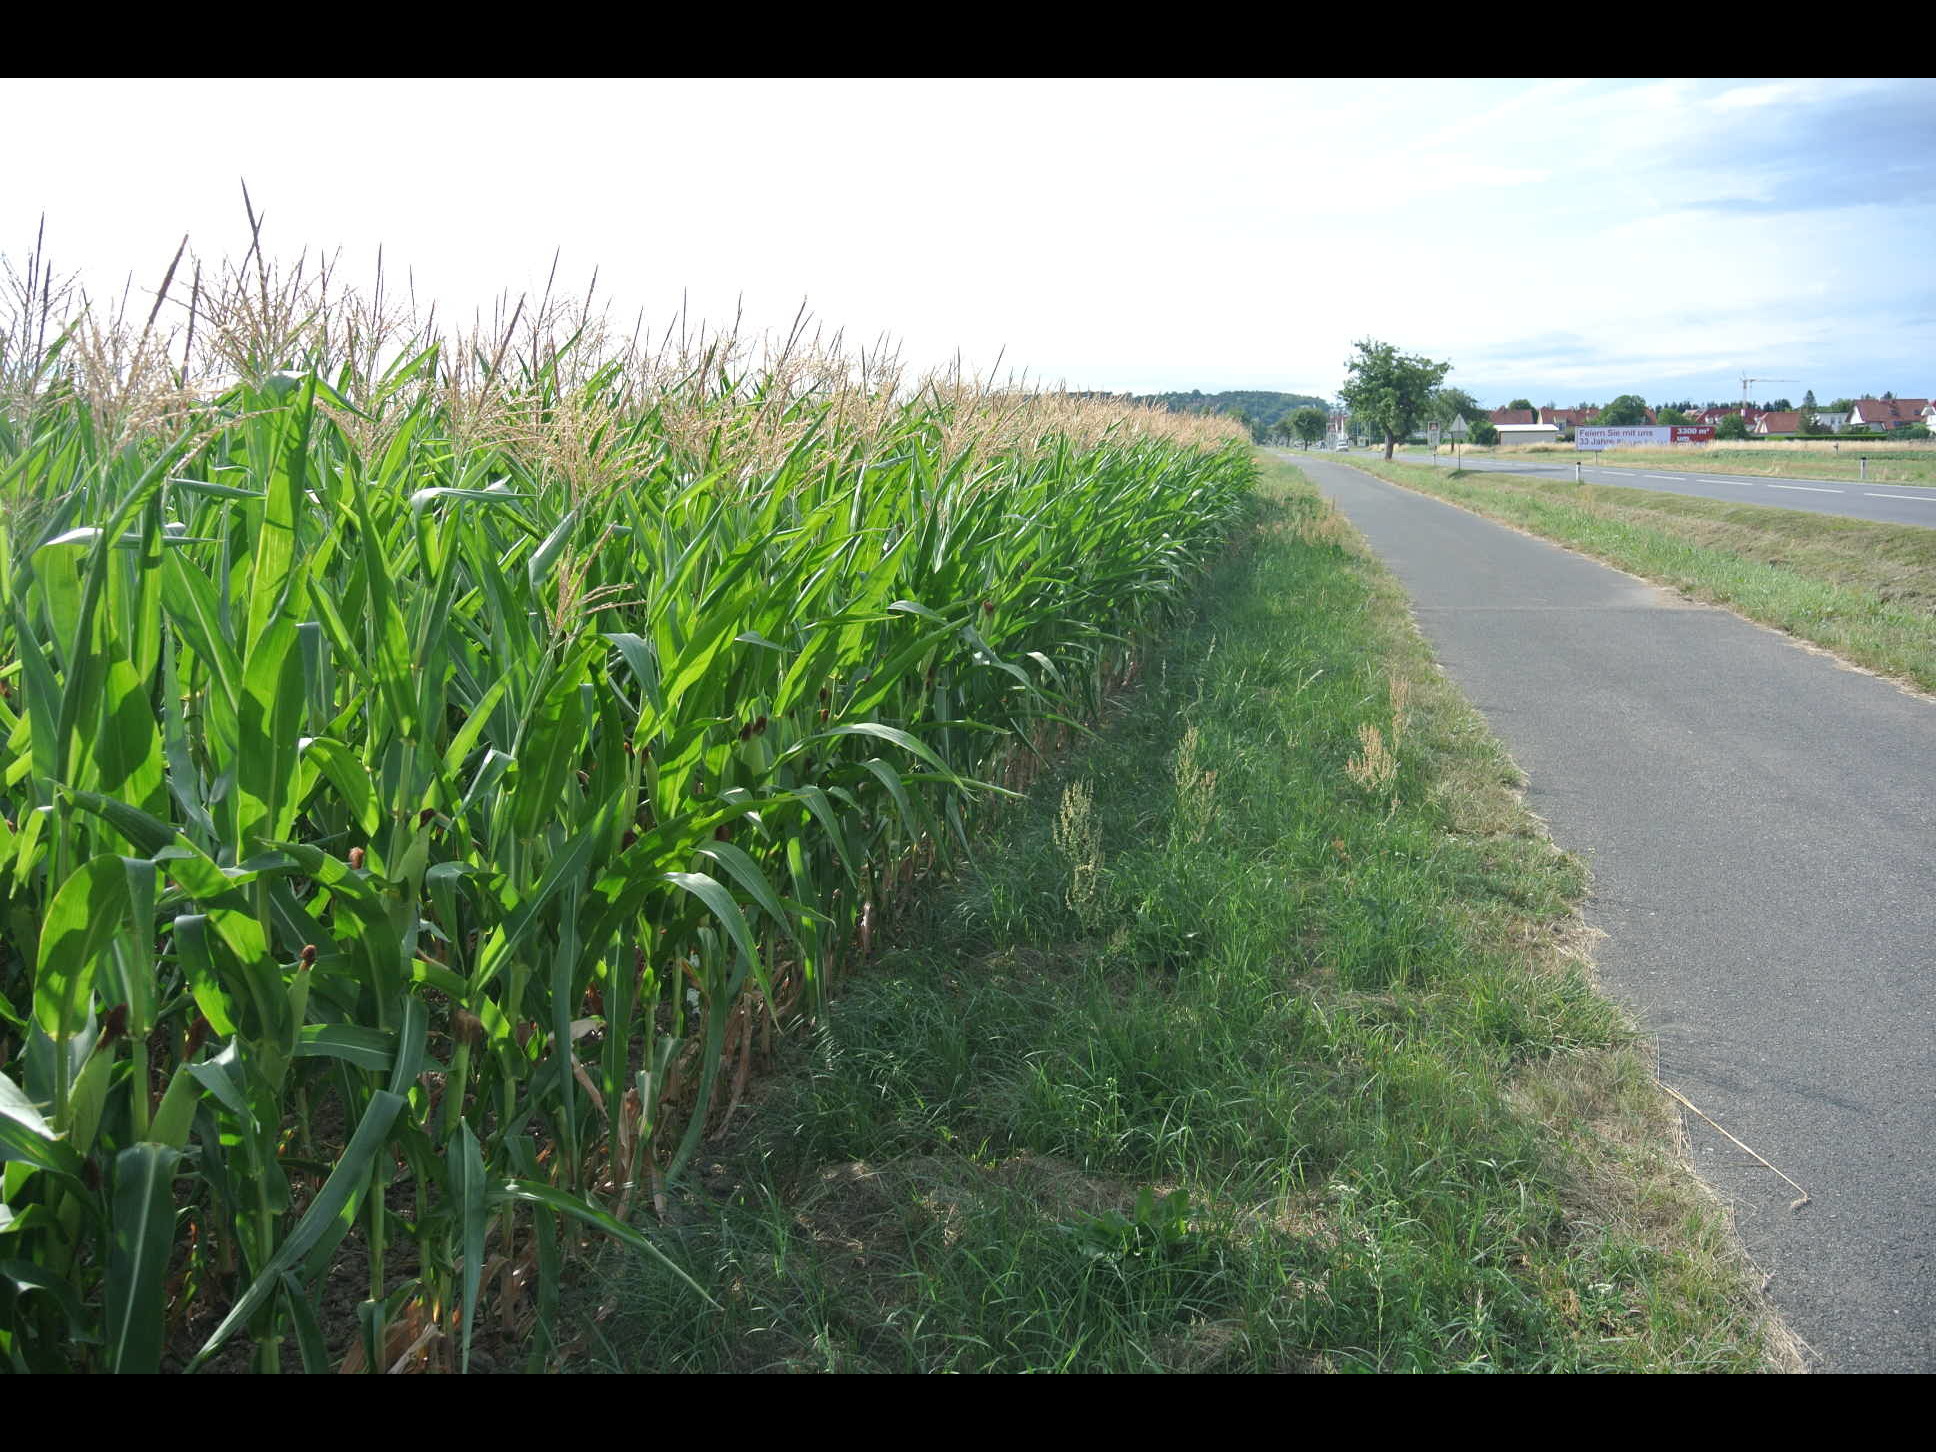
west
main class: Cropland
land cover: Maize
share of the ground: > 75 %
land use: Agriculture (excluding fallow land and kitchen gardens)
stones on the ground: < 10 %
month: July
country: AT
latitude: 47.4888
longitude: 16.5206
